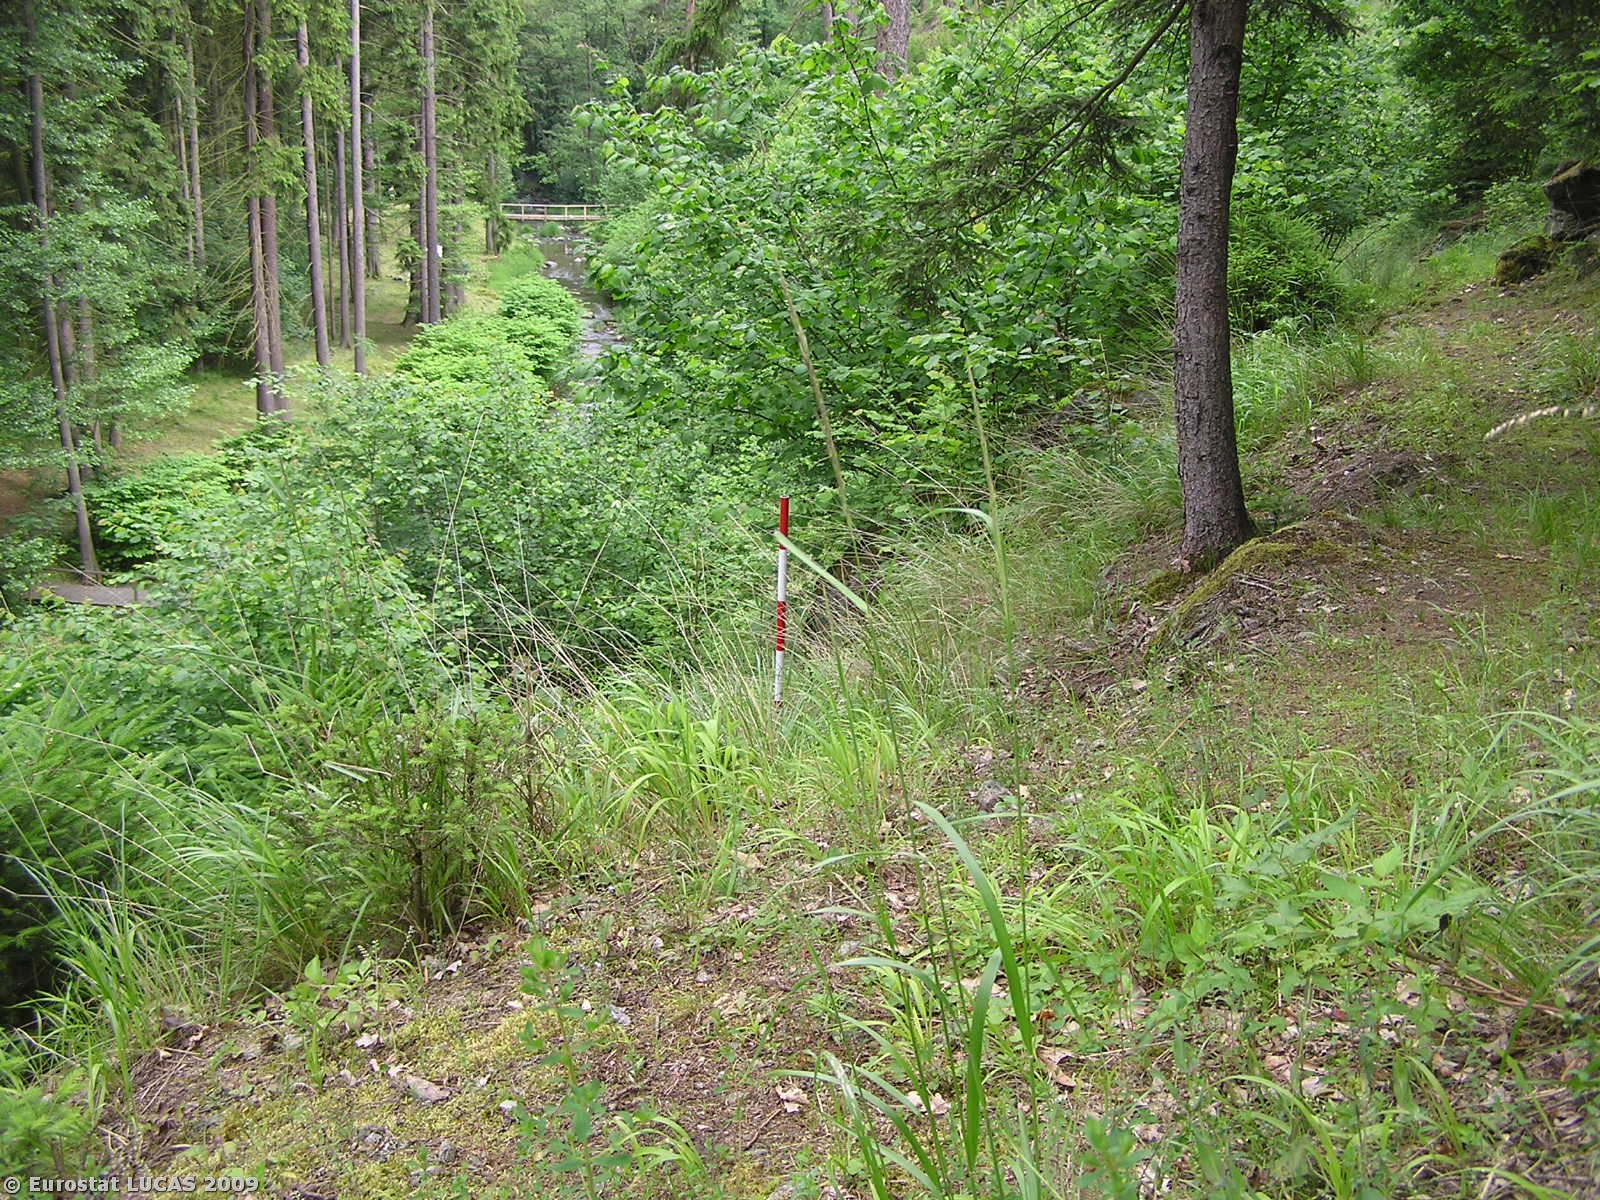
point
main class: Woodland
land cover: Mixed woodland
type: hemiboreal forest and nemoral coniferous forest and mixed broadleaved-coniferous forest
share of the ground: 50 - 75 %
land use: Forestry
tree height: > 5 m
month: June
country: CZ
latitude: 49.7662
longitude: 14.6251
